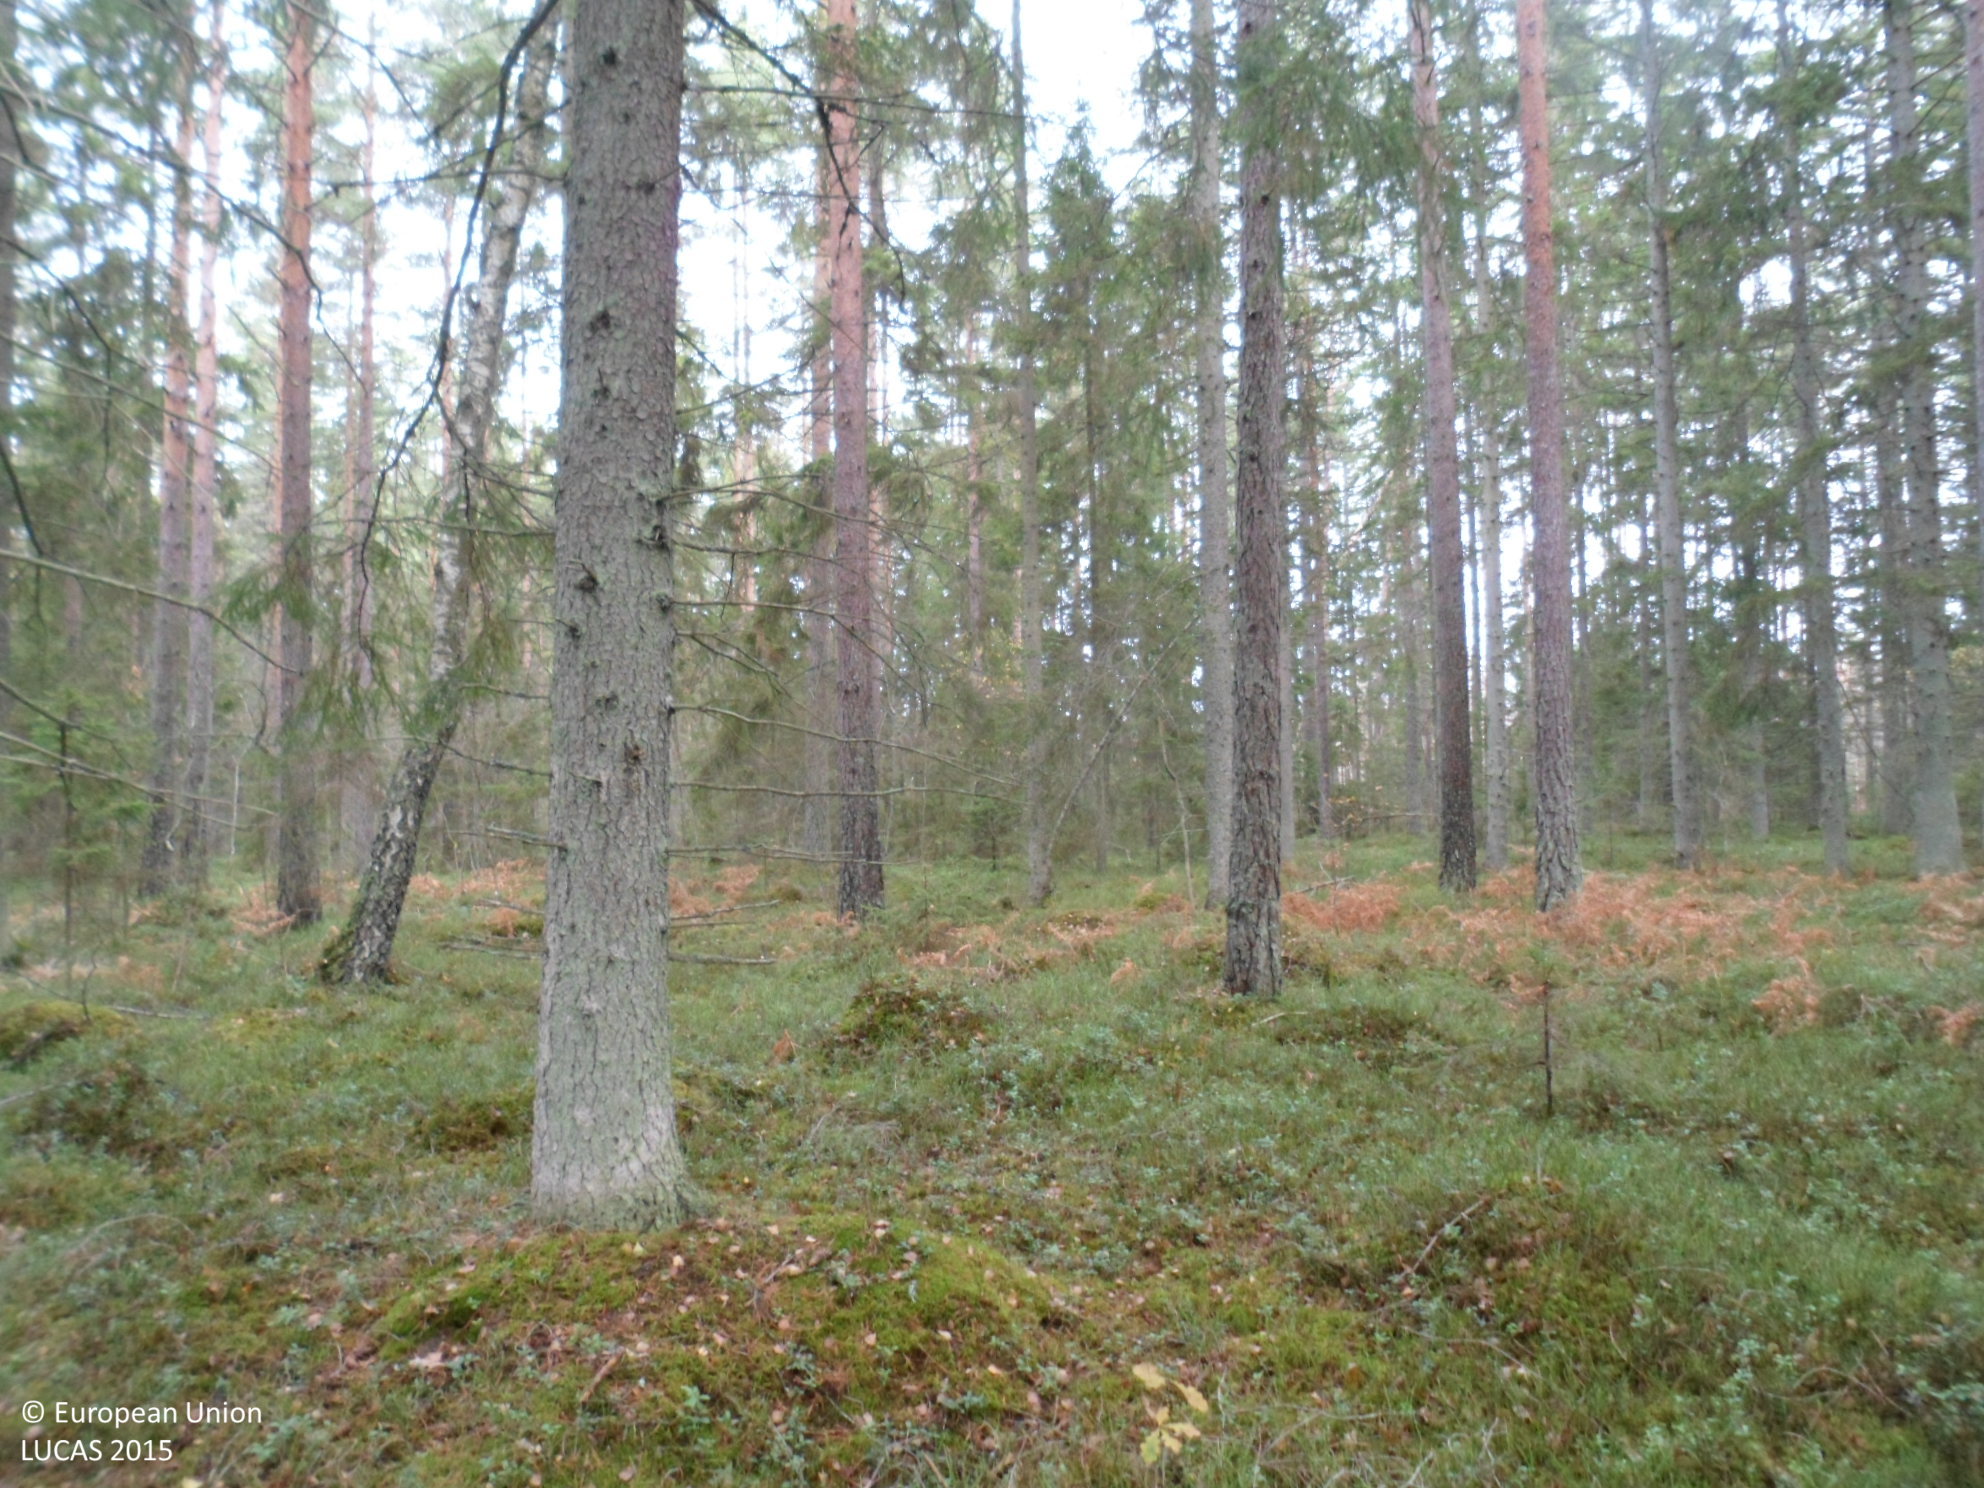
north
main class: Woodland
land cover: Spruce dominated coniferous woodland
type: boreal forest
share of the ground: 50 - 75 %
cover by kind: coniferous forest trees 60 %, lichens and mosses 20 %, shrubs 15 %, broadleaved forest trees 5 %
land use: Forestry
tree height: > 5 m
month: November
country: SE
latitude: 56.7566
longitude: 15.8711
